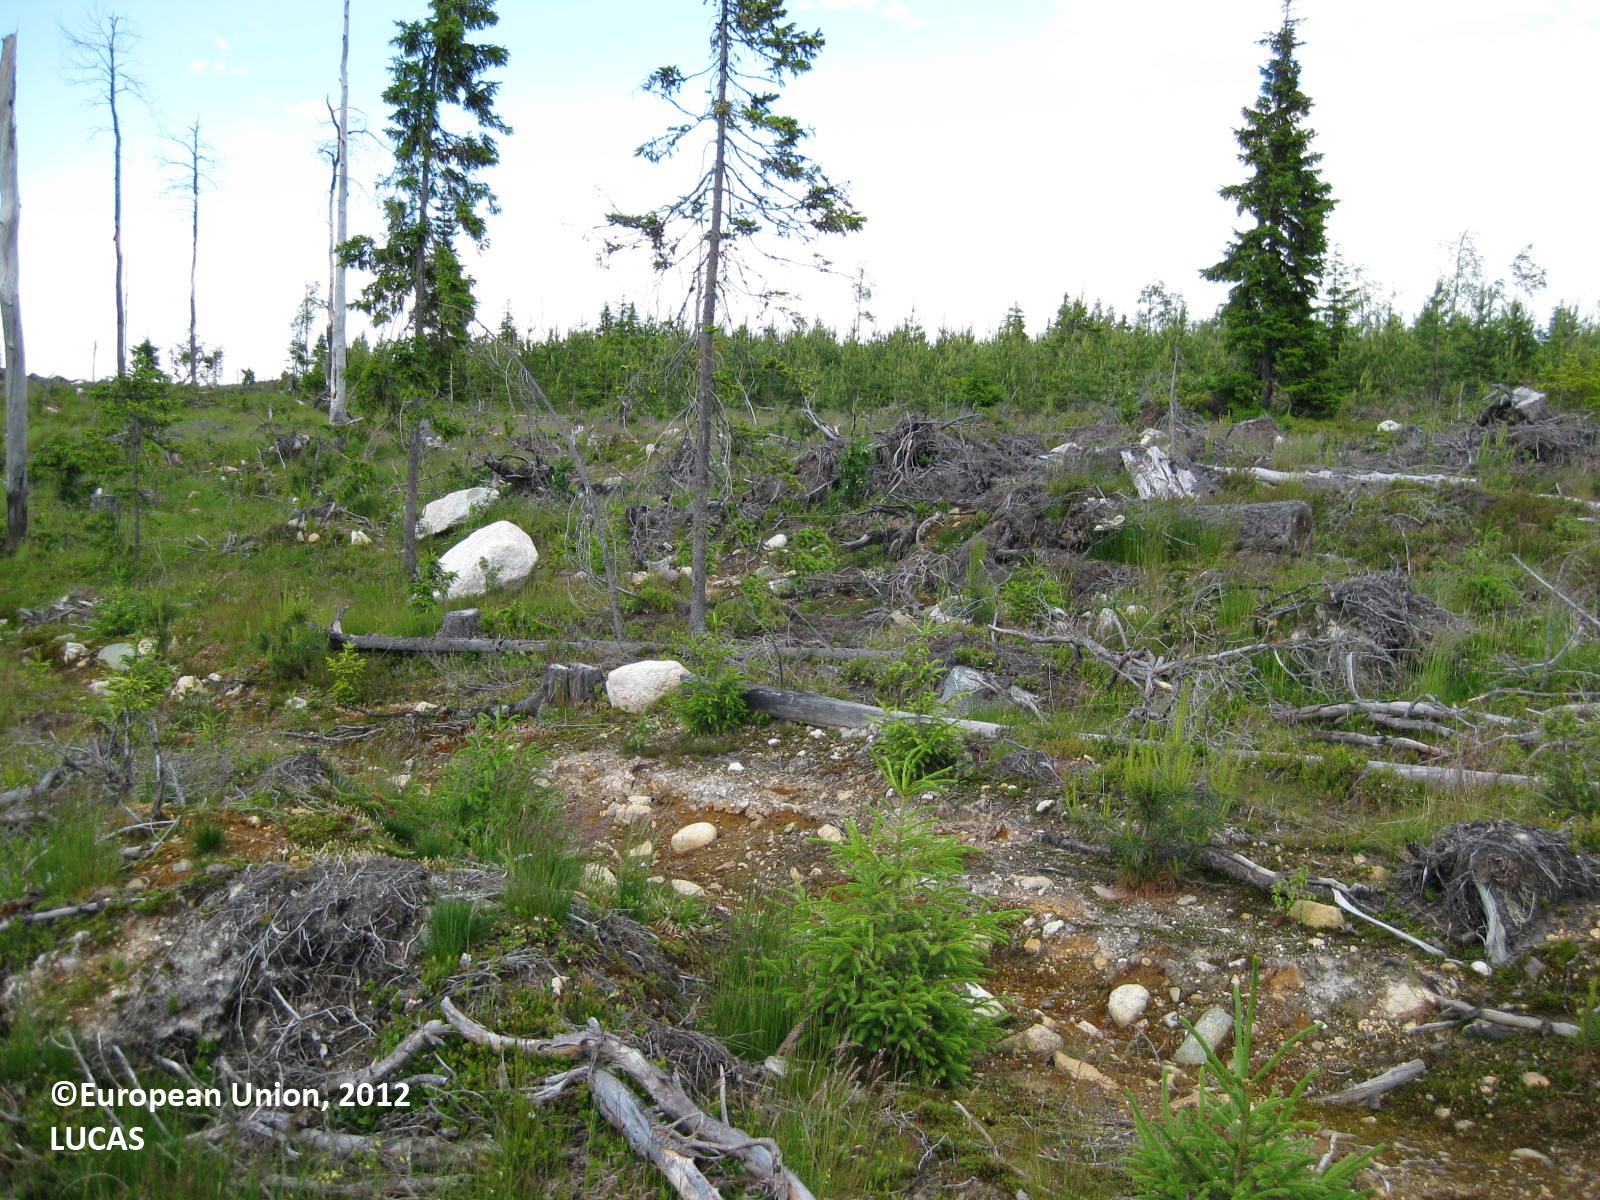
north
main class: Grassland
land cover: Grassland with sparse tree/shrub cover
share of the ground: > 75 %
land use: Forestry
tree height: < 5 m
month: July
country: FI
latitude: 65.5740
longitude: 29.4627
